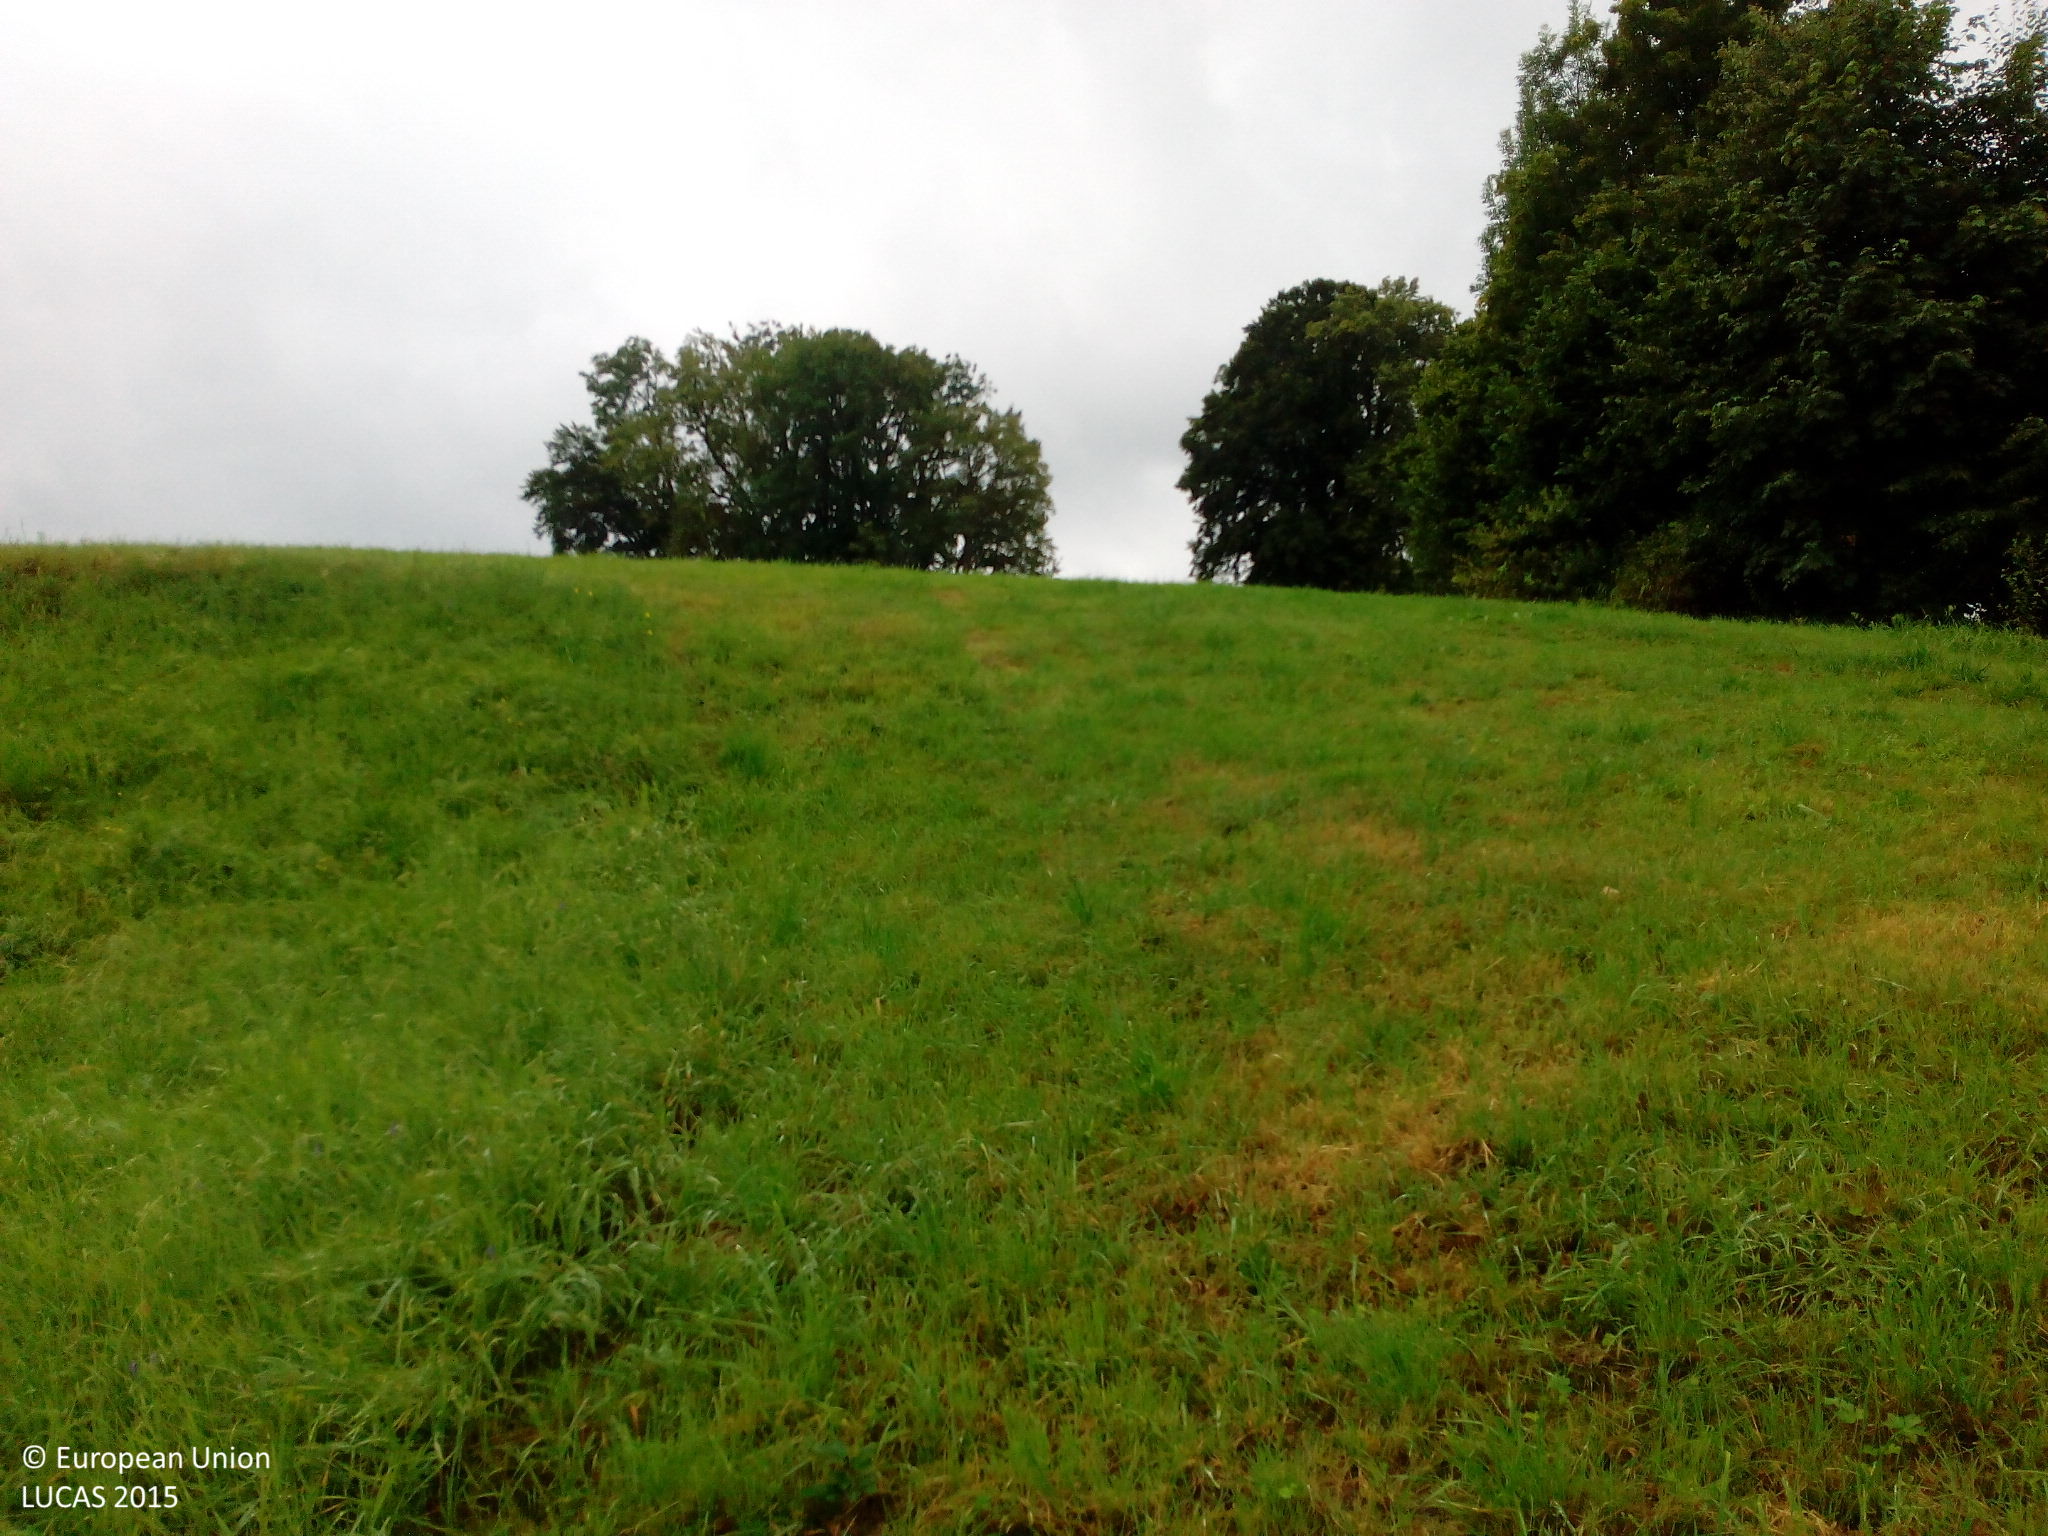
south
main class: Grassland
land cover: Grassland with sparse tree/shrub cover
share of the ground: > 75 %
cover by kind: herbaceous plants 95 %, broadleaved forest trees 5 %
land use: Residential
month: August
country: DE
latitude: 47.8260
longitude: 12.8706
